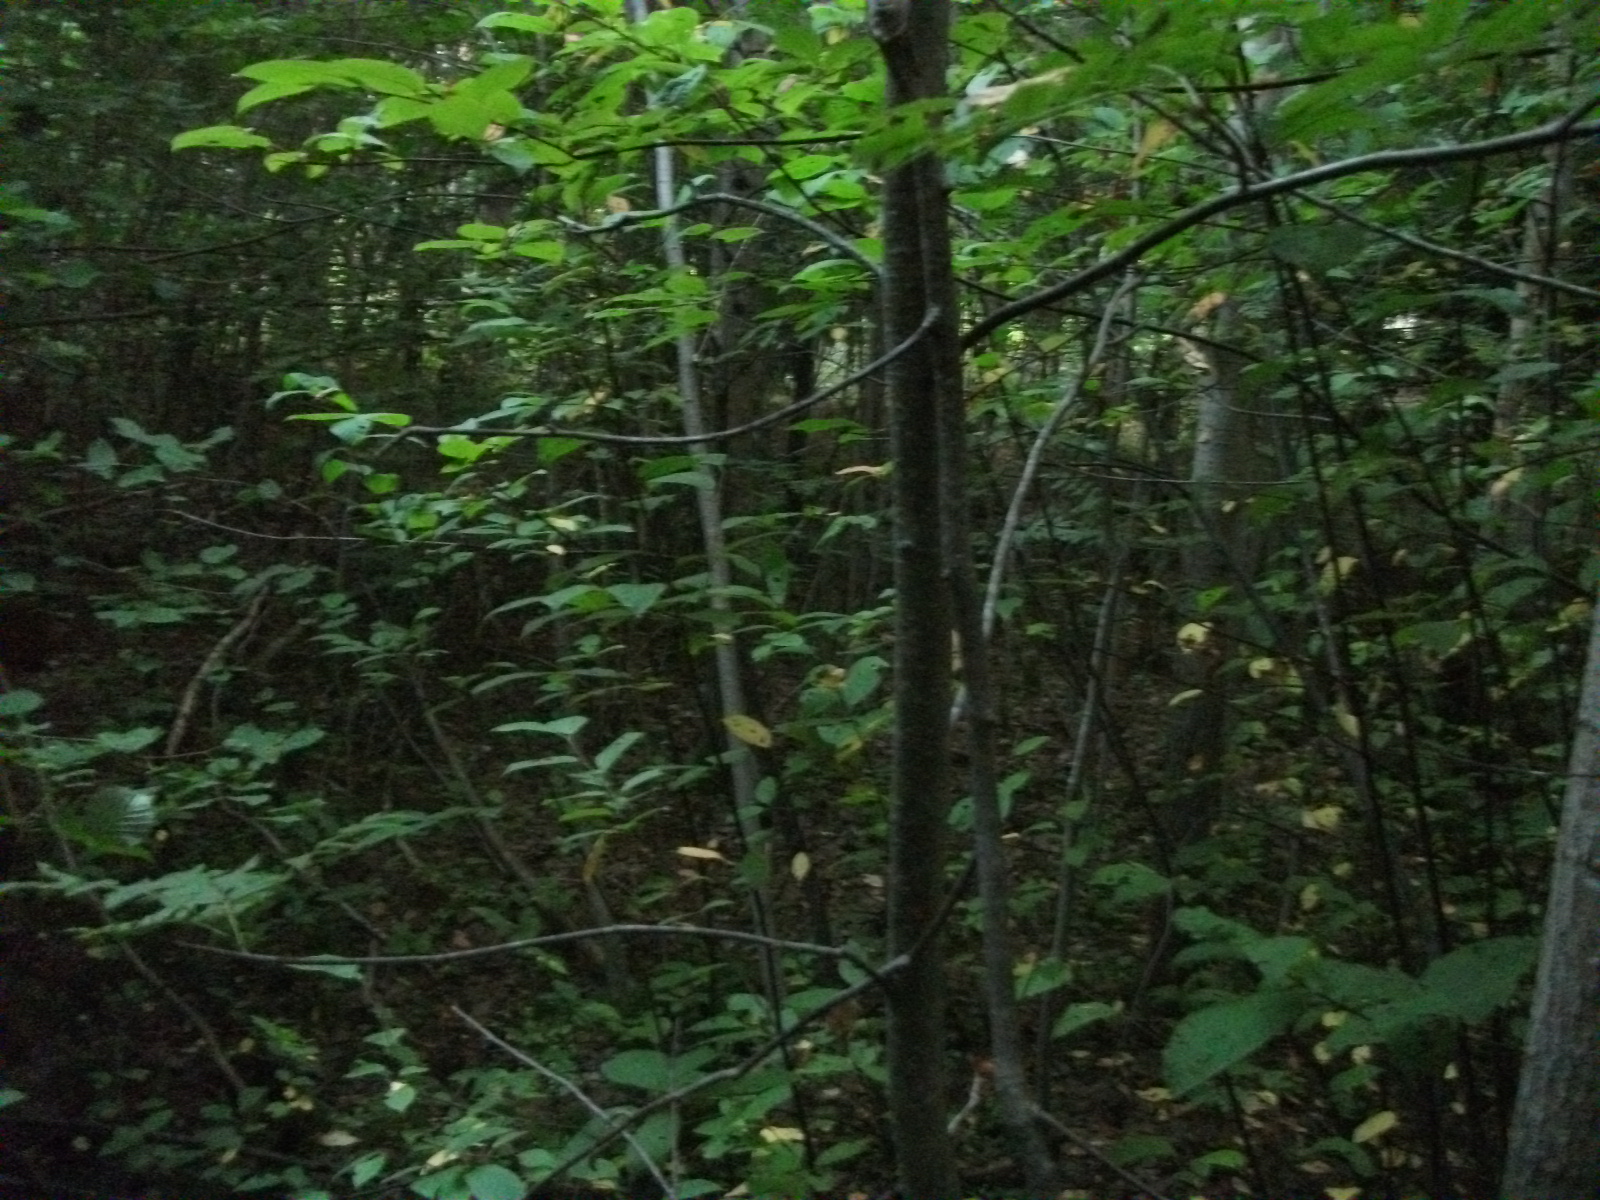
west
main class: Woodland
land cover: Broadleaved woodland
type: non-riverine alder, birch or aspen forest
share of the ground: > 75 %
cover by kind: broadleaved forest trees 90 %, shrubs 5 %, unconsolidated bare surface 5 %
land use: Forestry
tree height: > 5 m
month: August
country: LV
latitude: 56.7529
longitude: 26.4505
